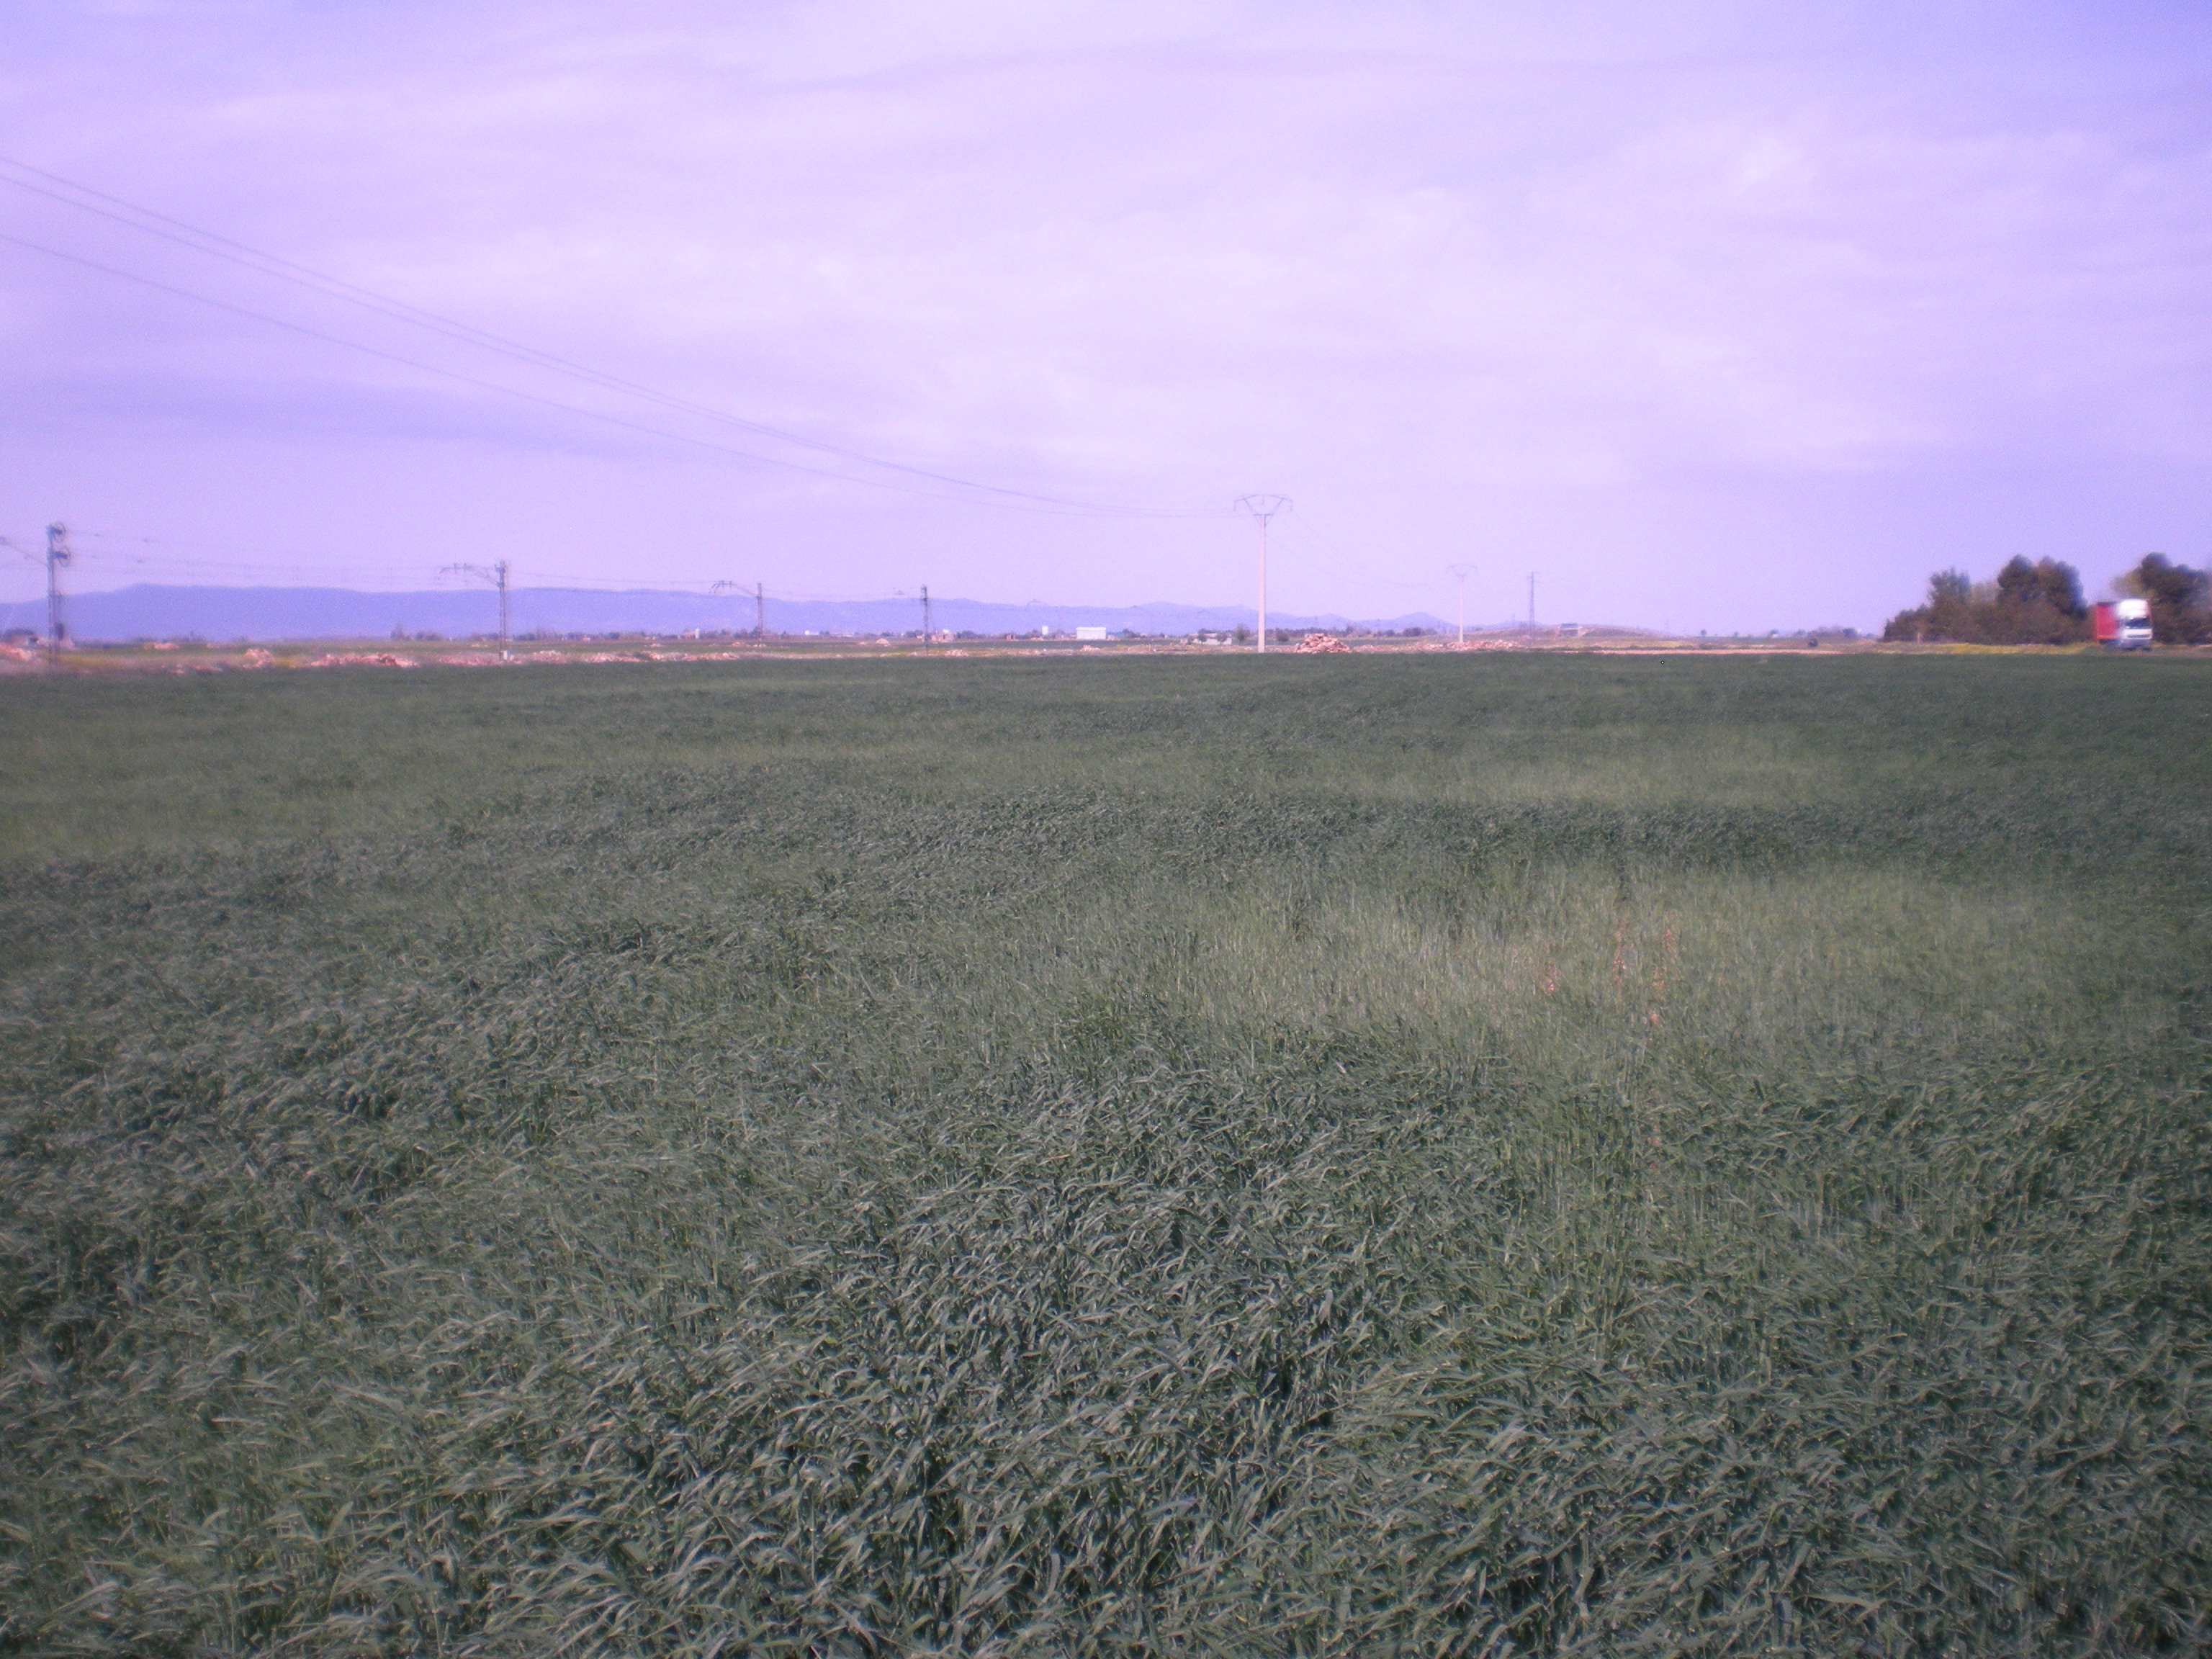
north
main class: Cropland
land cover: Barley
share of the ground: > 75 %
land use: Agriculture (excluding fallow land and kitchen gardens)
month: April
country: ES
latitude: 39.0174
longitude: -3.6343
